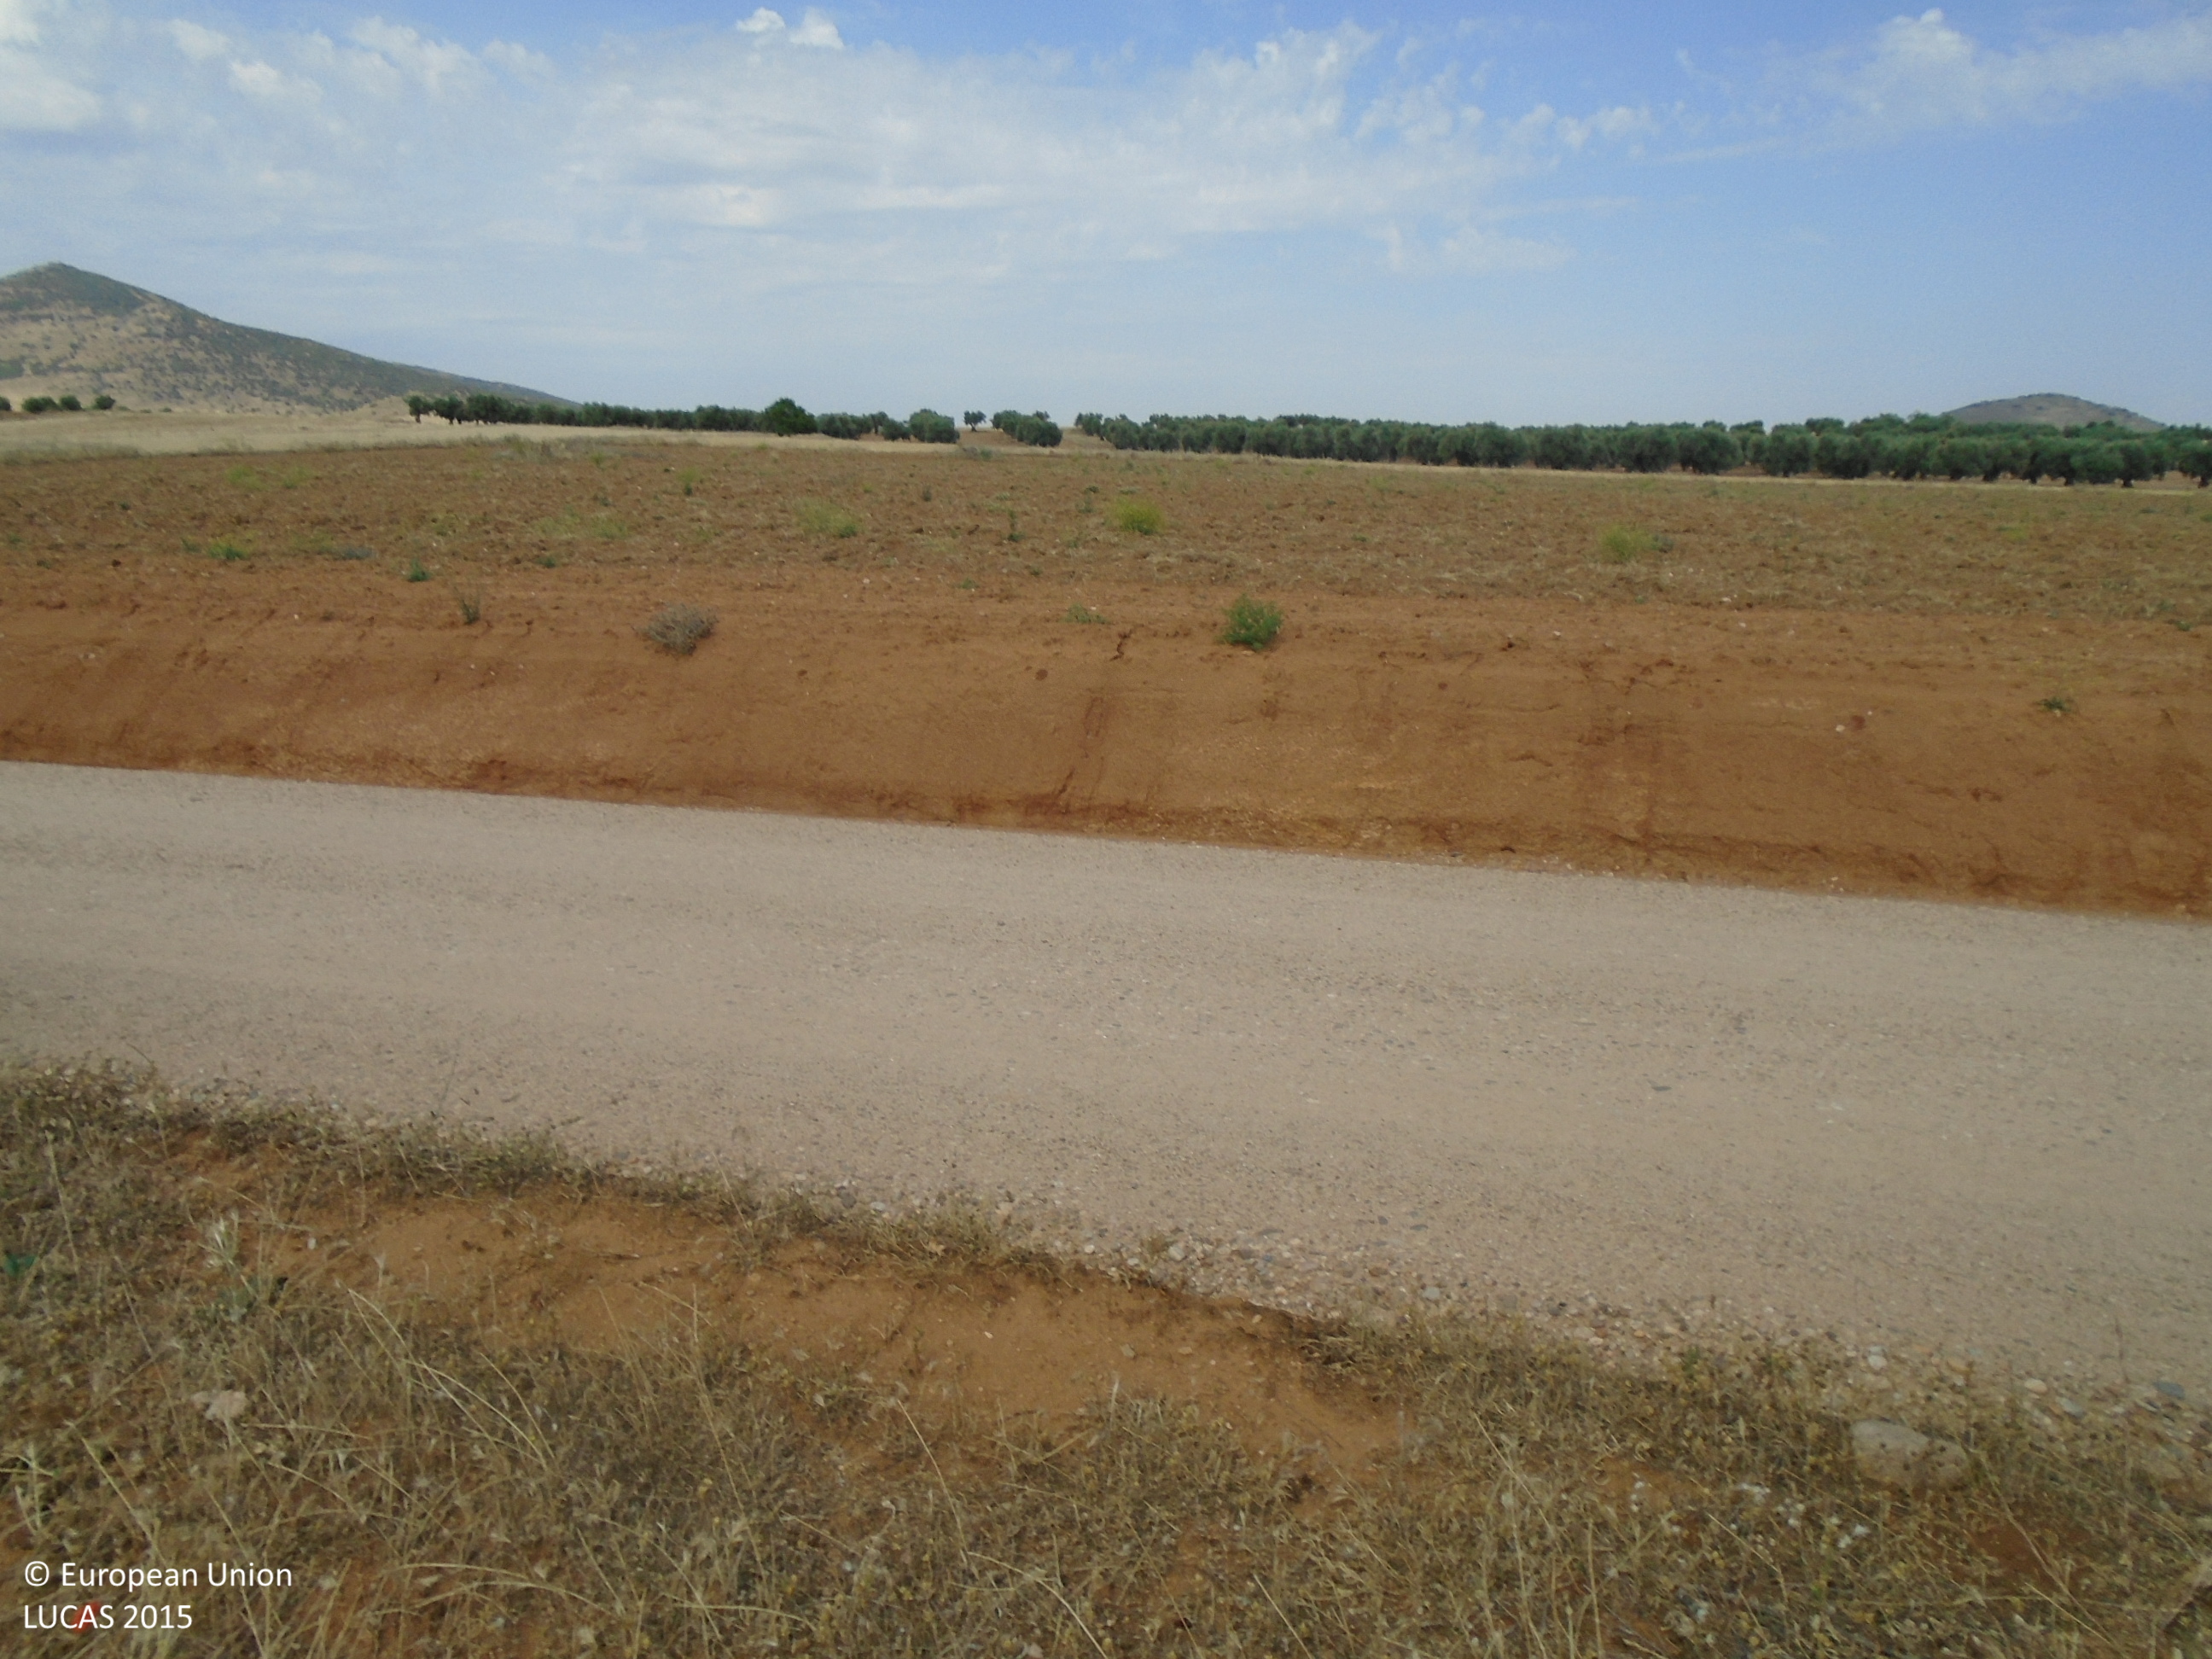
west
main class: Cropland
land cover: Olive groves
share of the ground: 10 - 25 %
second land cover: Other bare soil
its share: > 75 %
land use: Agriculture (excluding fallow land and kitchen gardens)
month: June
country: ES
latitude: 39.7647
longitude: -4.1714
